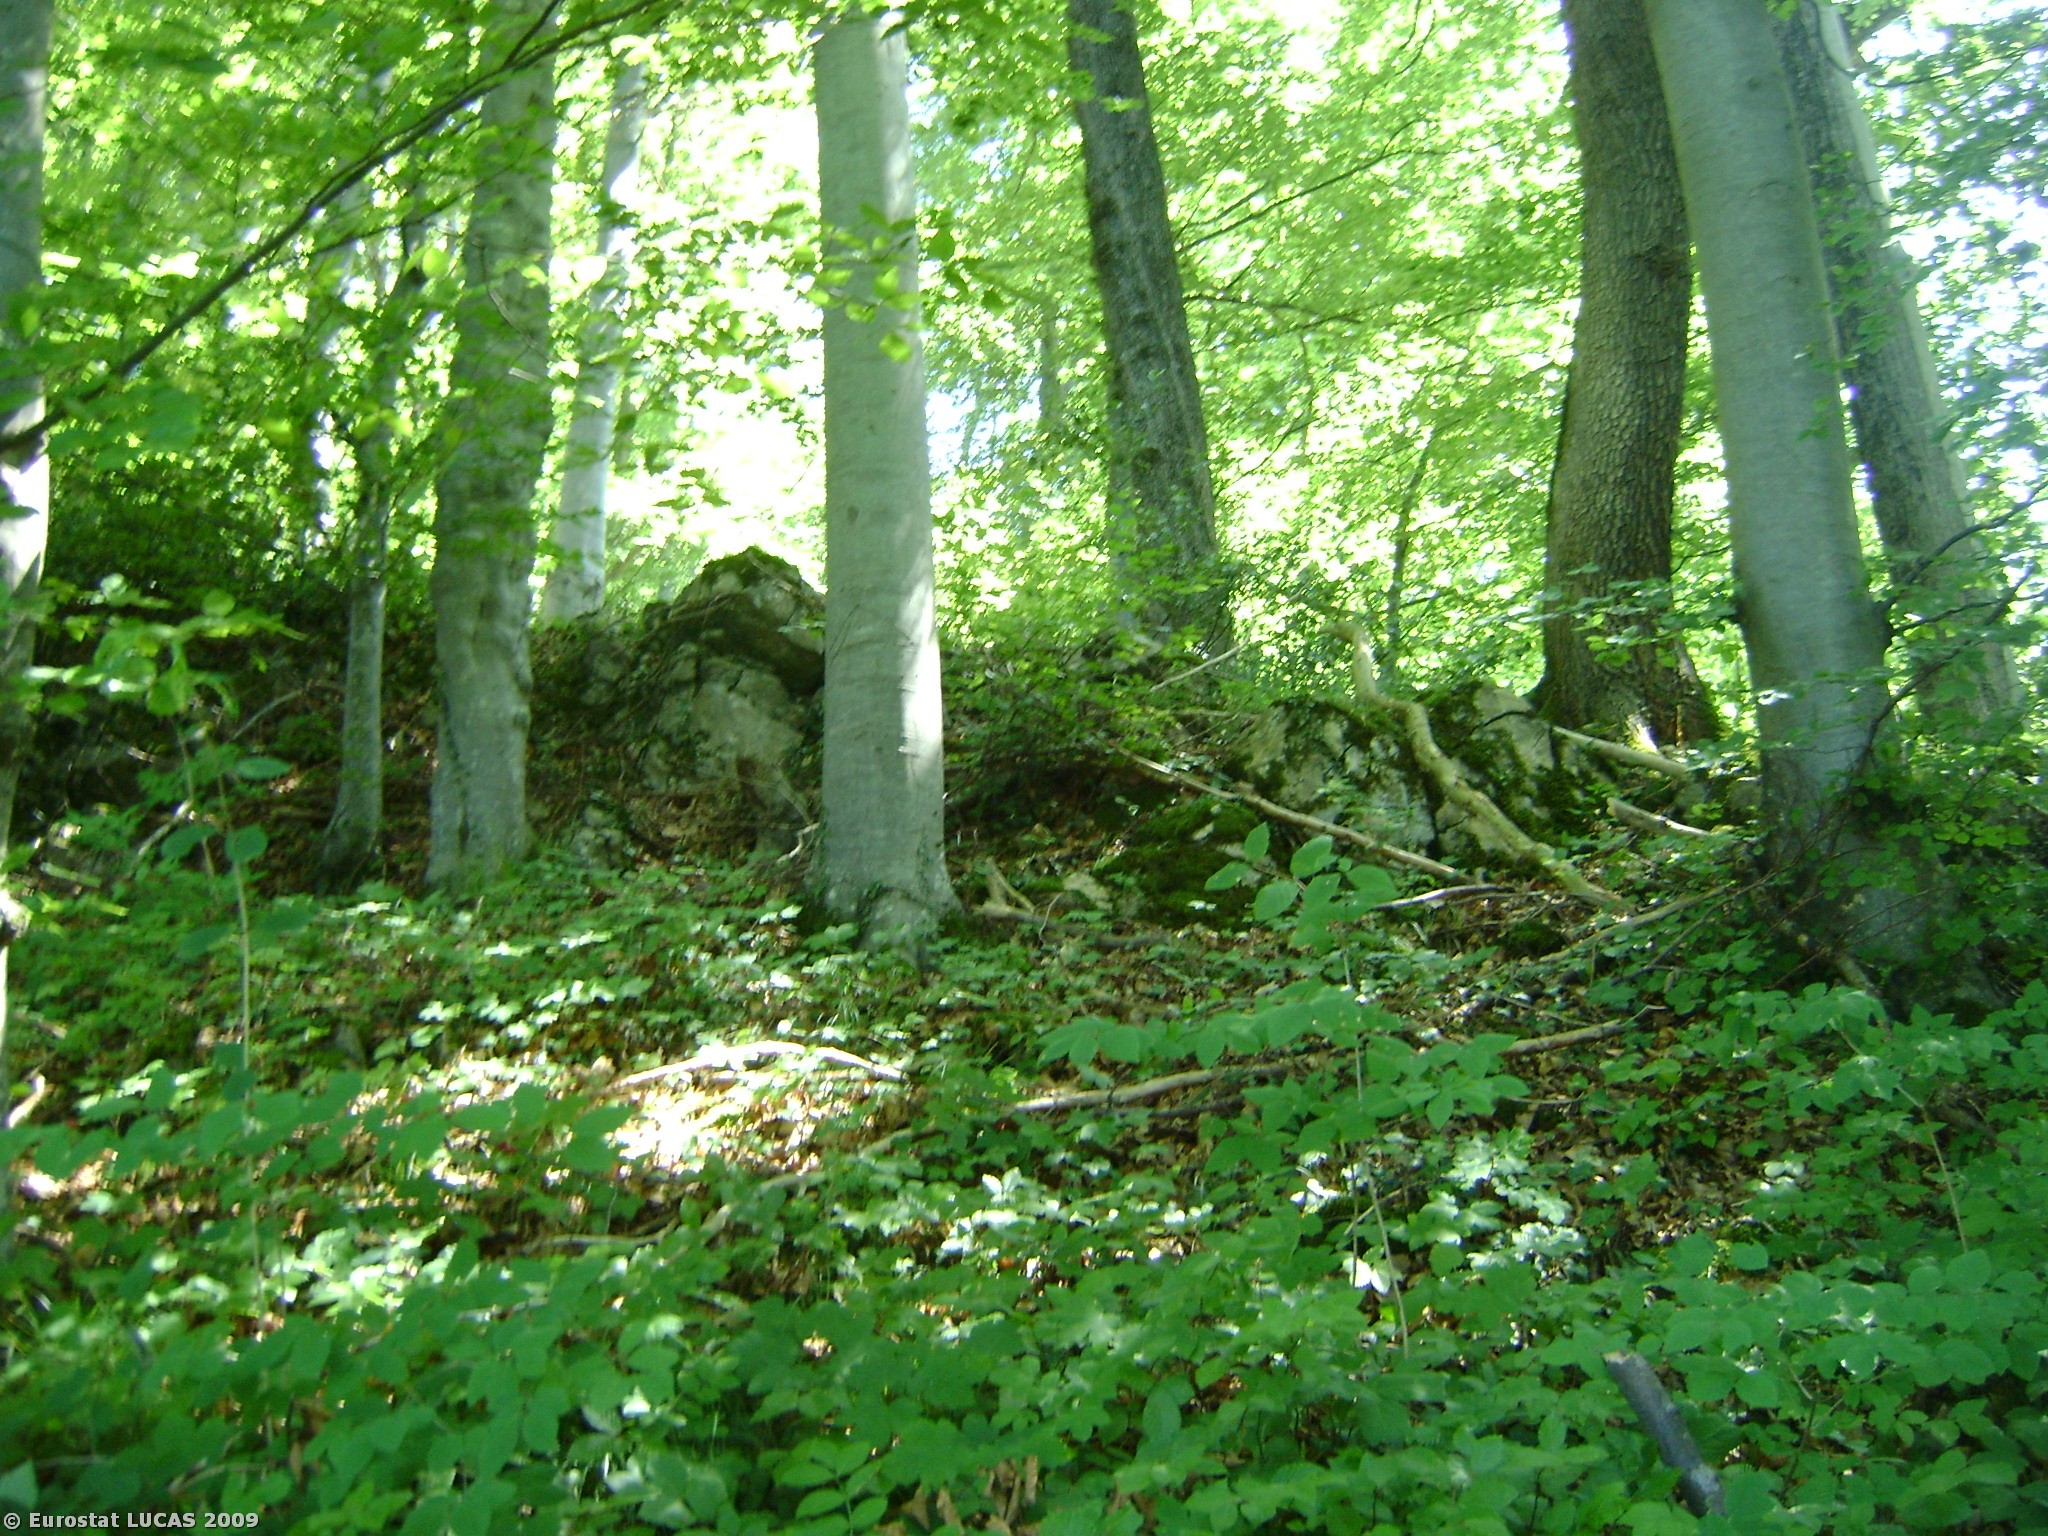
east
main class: Woodland
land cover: Broadleaved woodland
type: beech forest
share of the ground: > 75 %
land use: Forestry
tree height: > 5 m
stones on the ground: < 10 %
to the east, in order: Broadleaved woodland; Fences; Grassland without tree/shrub cover; Broadleaved woodland; Grassland without tree/shrub cover; Fences; Grassland with sparse tree/shrub cover; Fences; Grassland with sparse tree/shrub cover
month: July
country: AT
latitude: 47.3411
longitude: 9.6694
